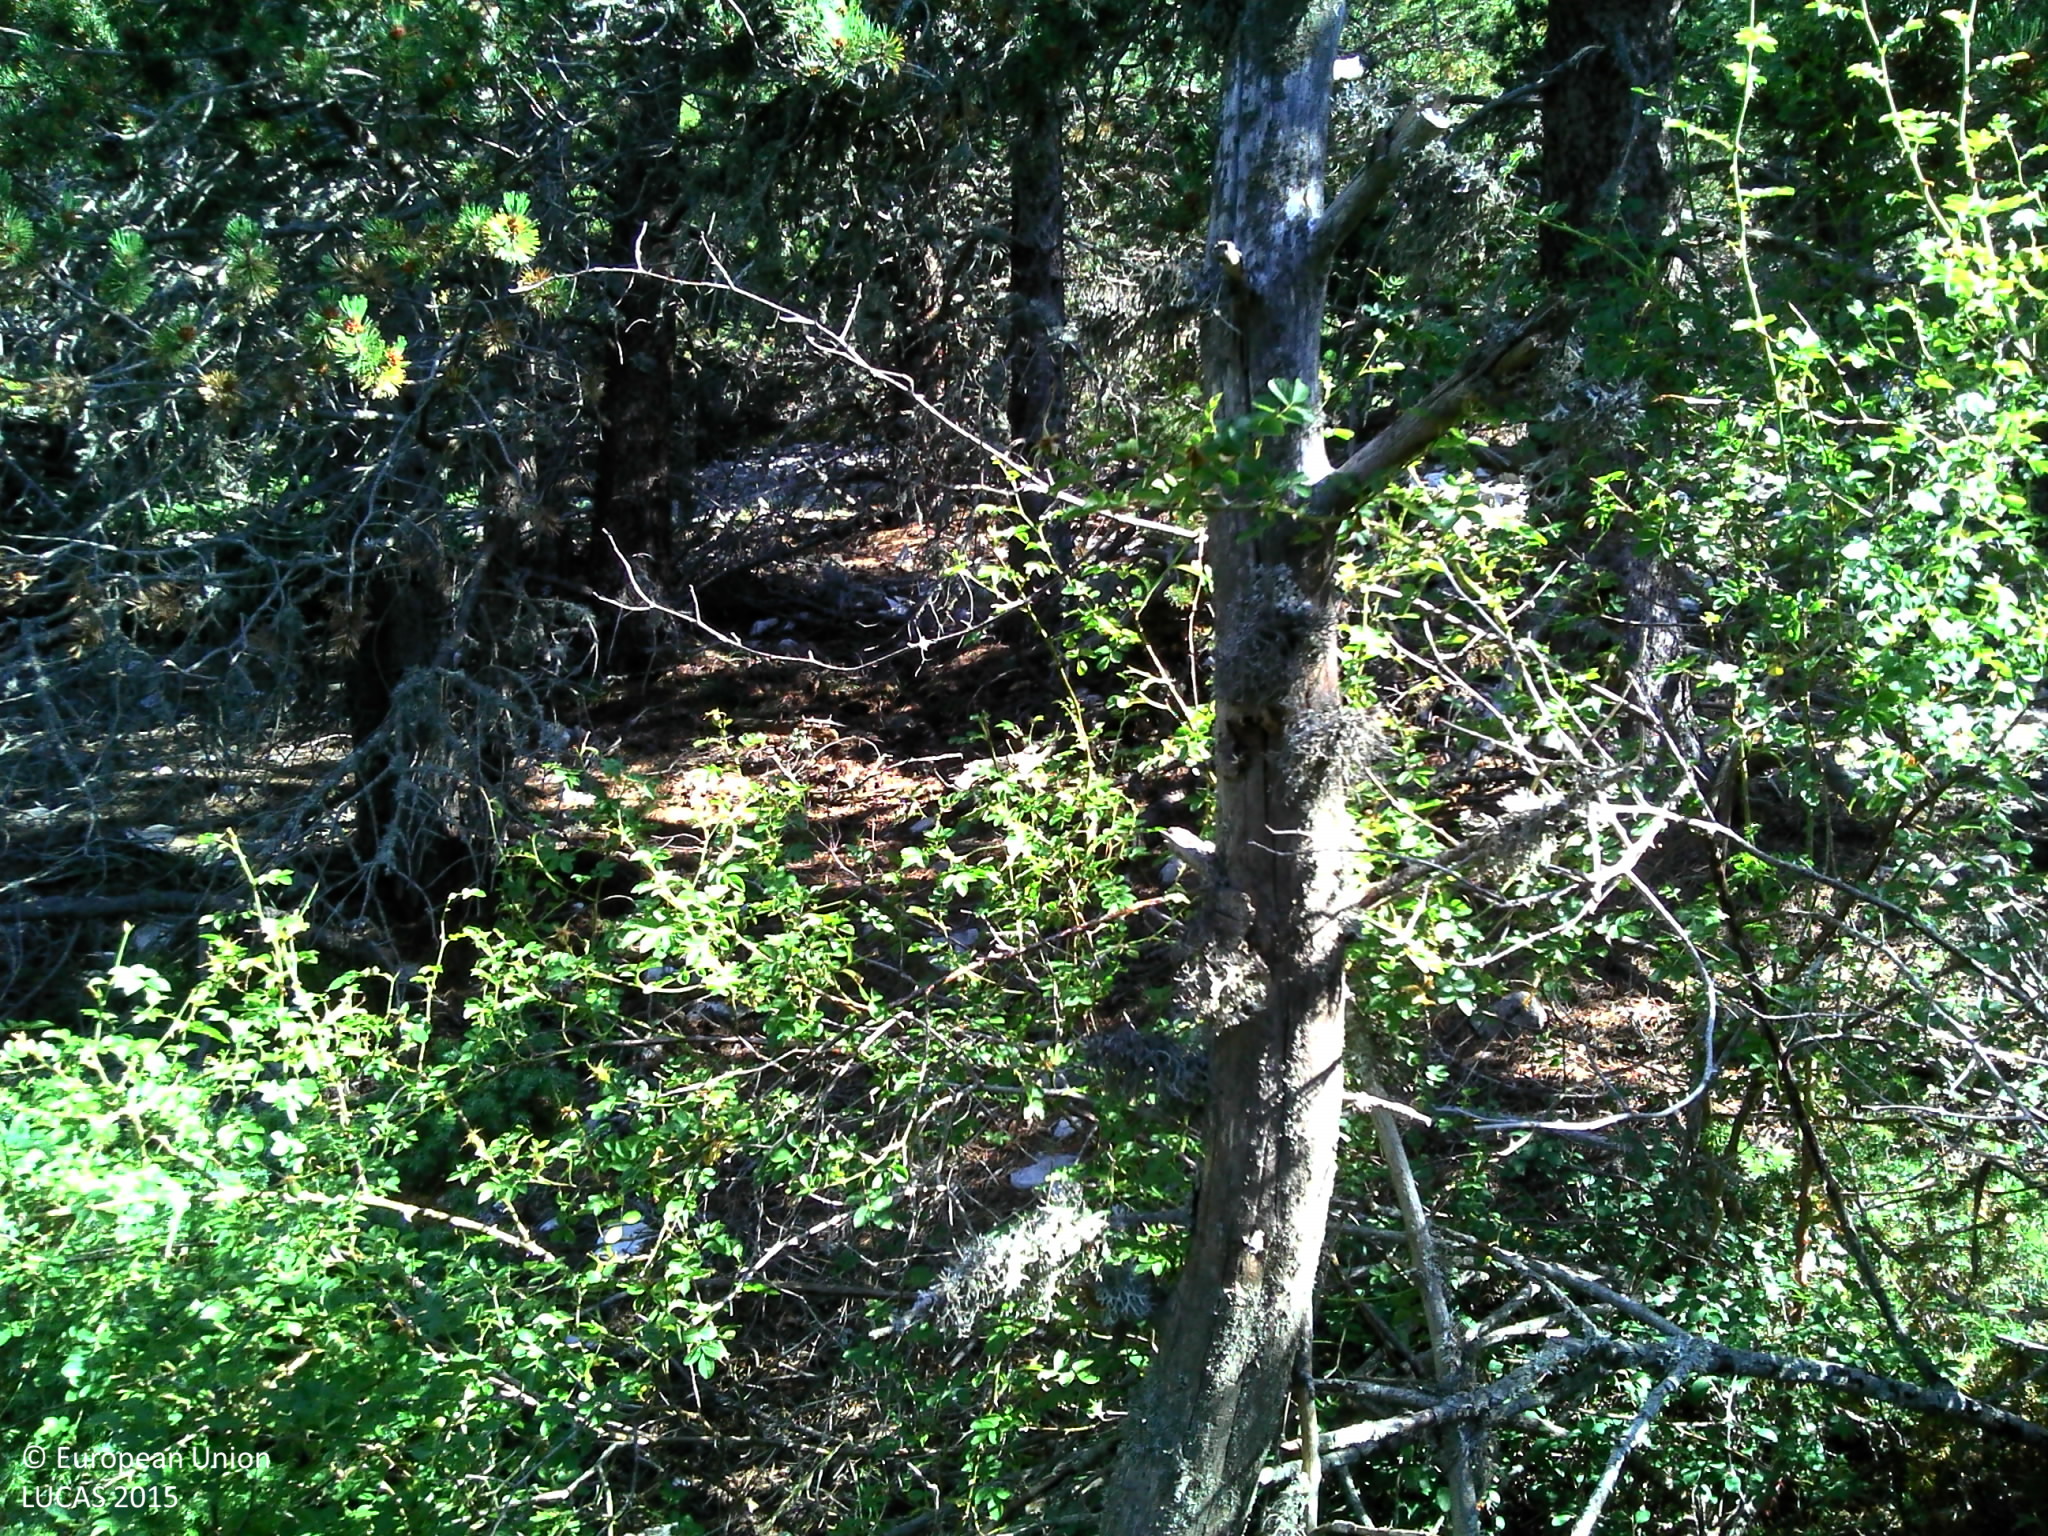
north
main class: Woodland
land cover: Other coniferous woodland
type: coniferous forest of the mediterranean region
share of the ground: > 75 %
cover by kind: coniferous forest trees 45 %, lichens and mosses 15 %, unconsolidated bare surface 15 %, shrubs 10 %, herbaceous plants 10 %, broadleaved forest trees 5 %
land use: Semi-natural and natural areas not in use
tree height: > 5 m
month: July
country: FR
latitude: 44.1692
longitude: 5.2430
